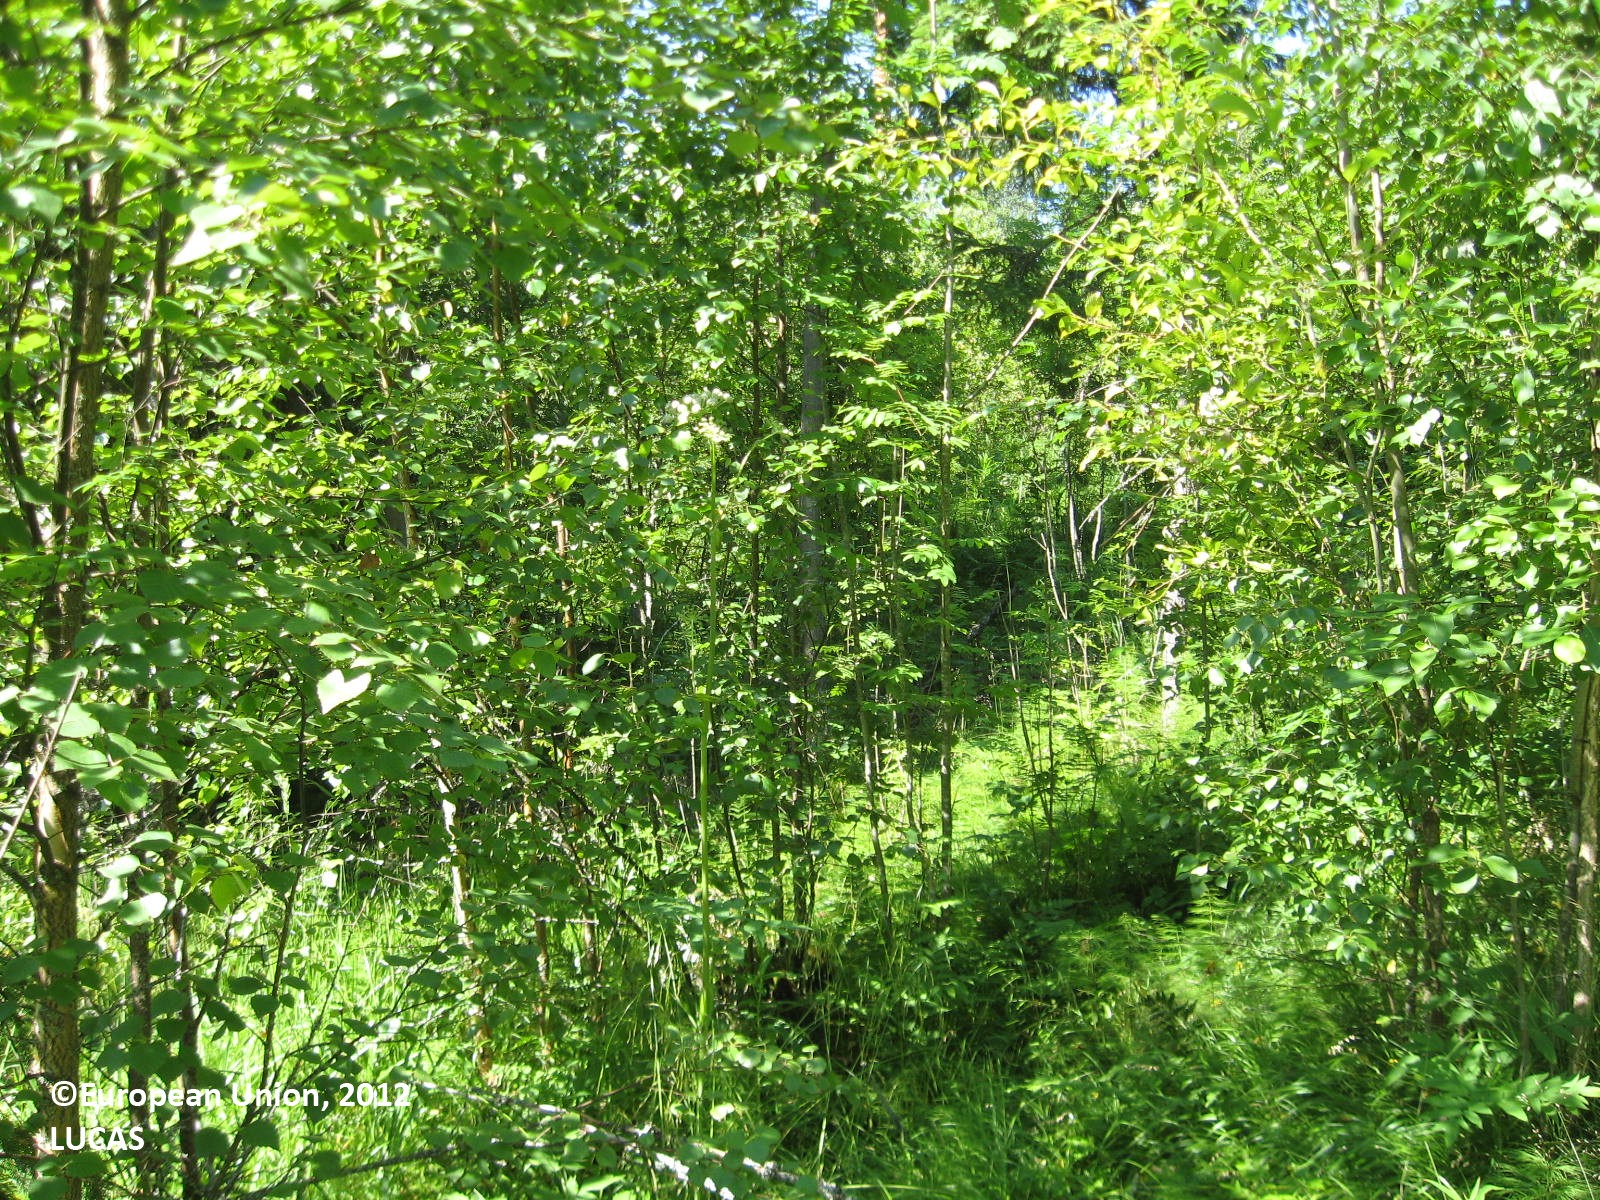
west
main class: Woodland
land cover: Other mixed woodland
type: boreal forest
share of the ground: > 75 %
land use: Forestry
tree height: > 5 m
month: July
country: FI
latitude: 61.9277
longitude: 22.8857
